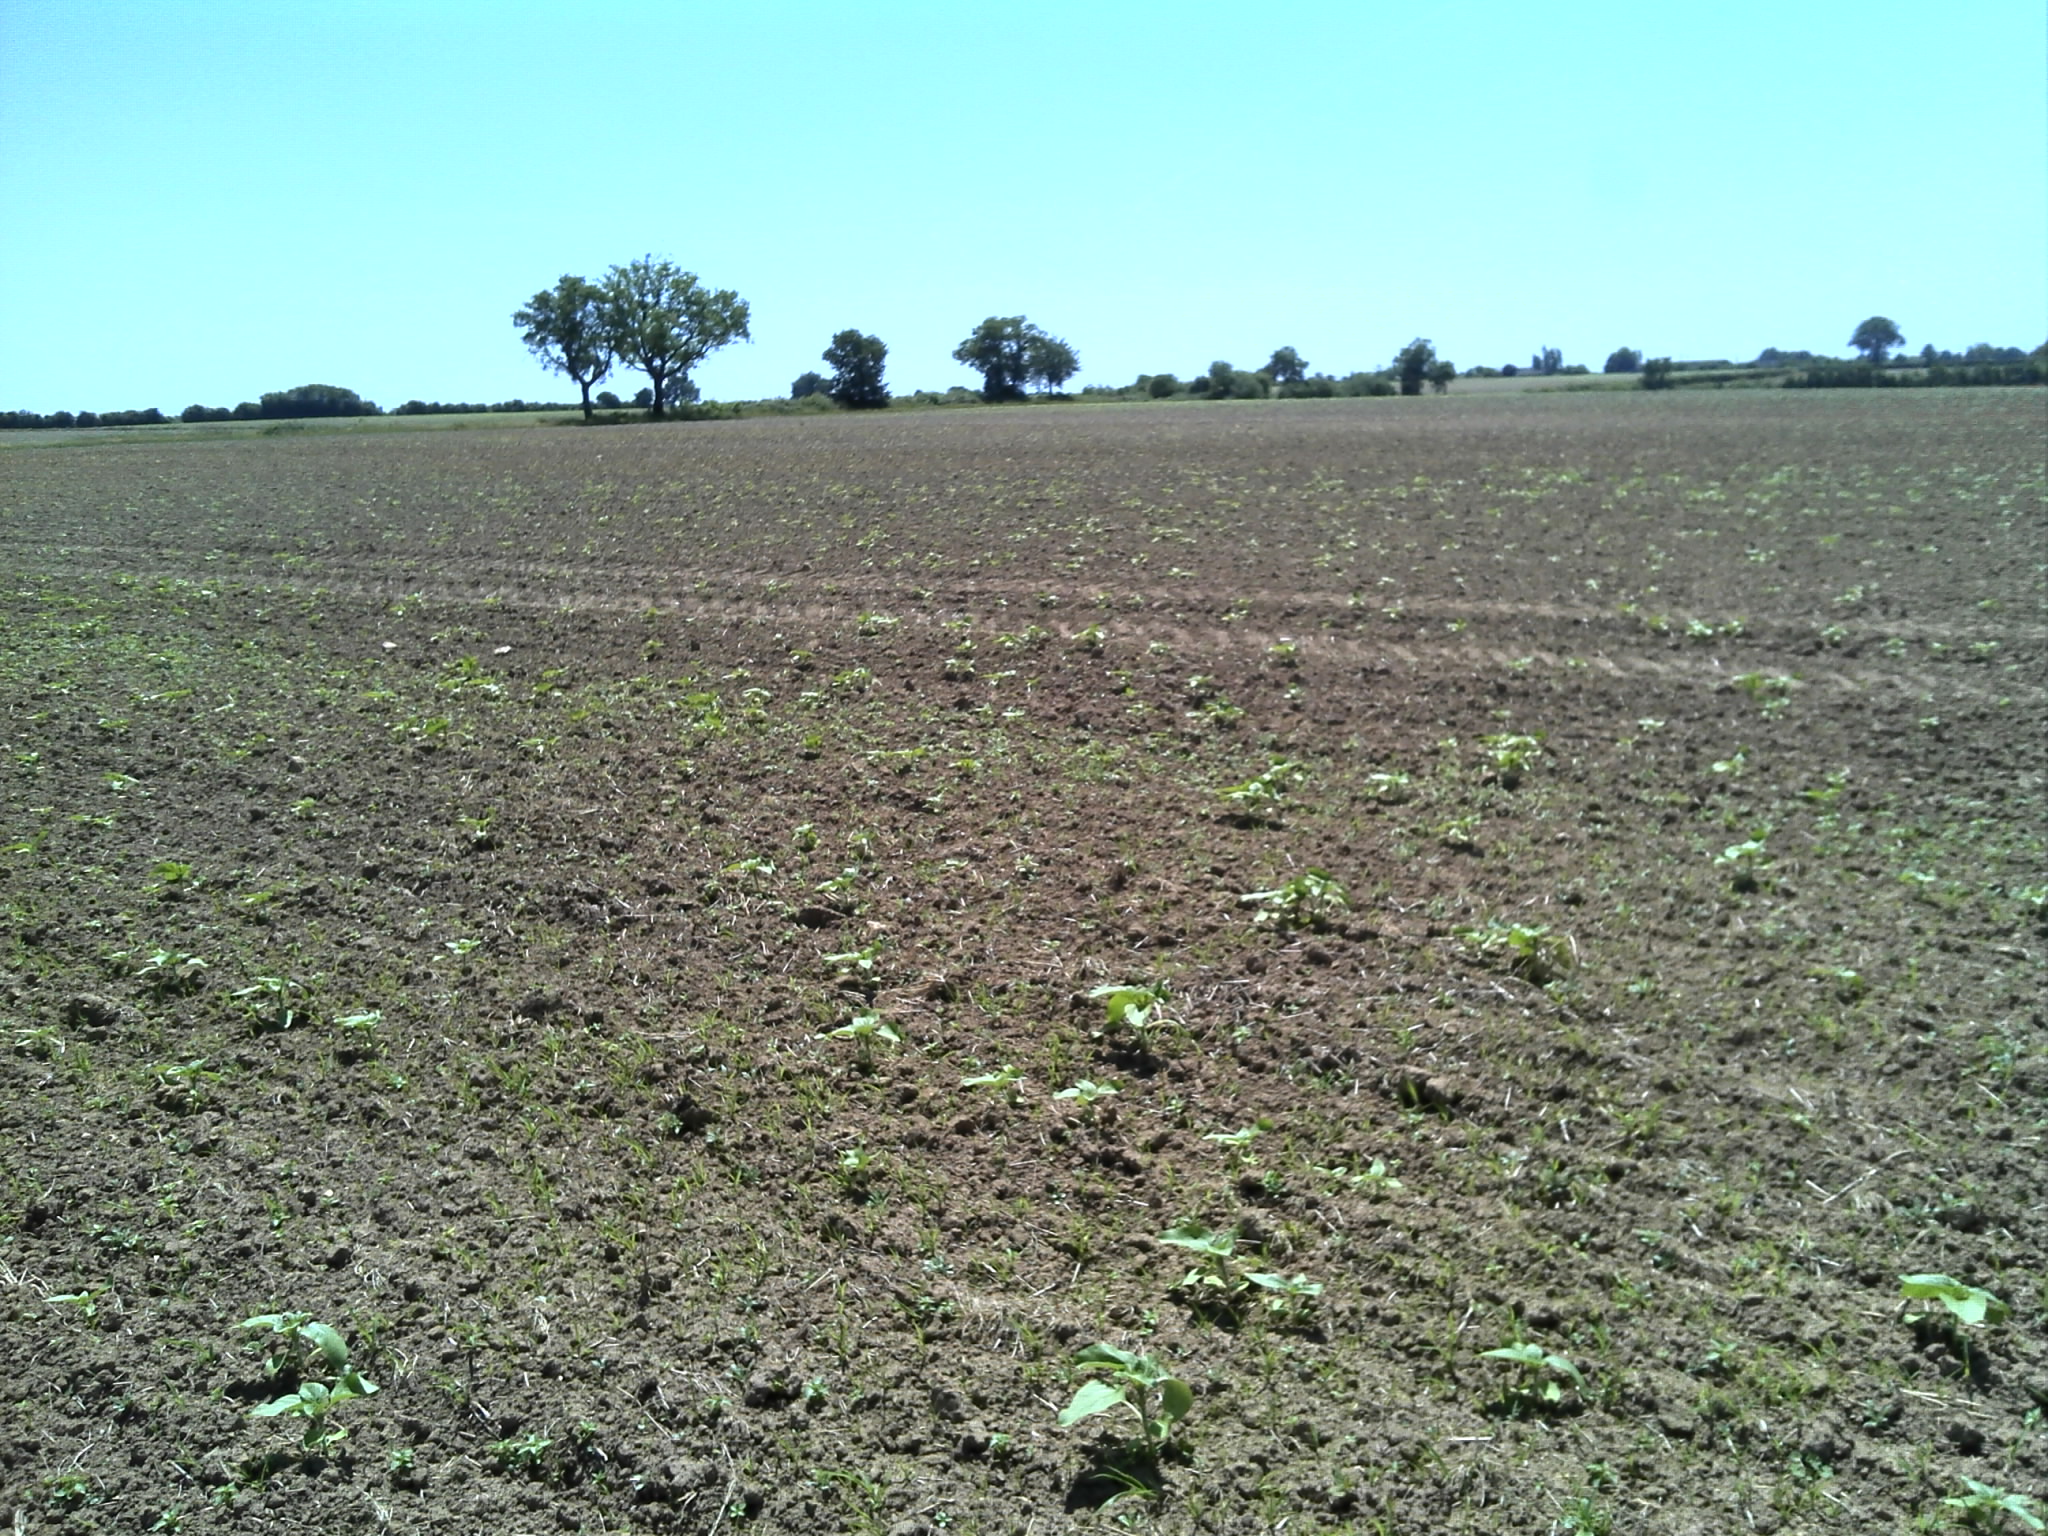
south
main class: Cropland
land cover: Sunflower
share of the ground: 10 - 25 %
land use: Agriculture (excluding fallow land and kitchen gardens)
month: June
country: FR
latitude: 46.5996
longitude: 1.1494
